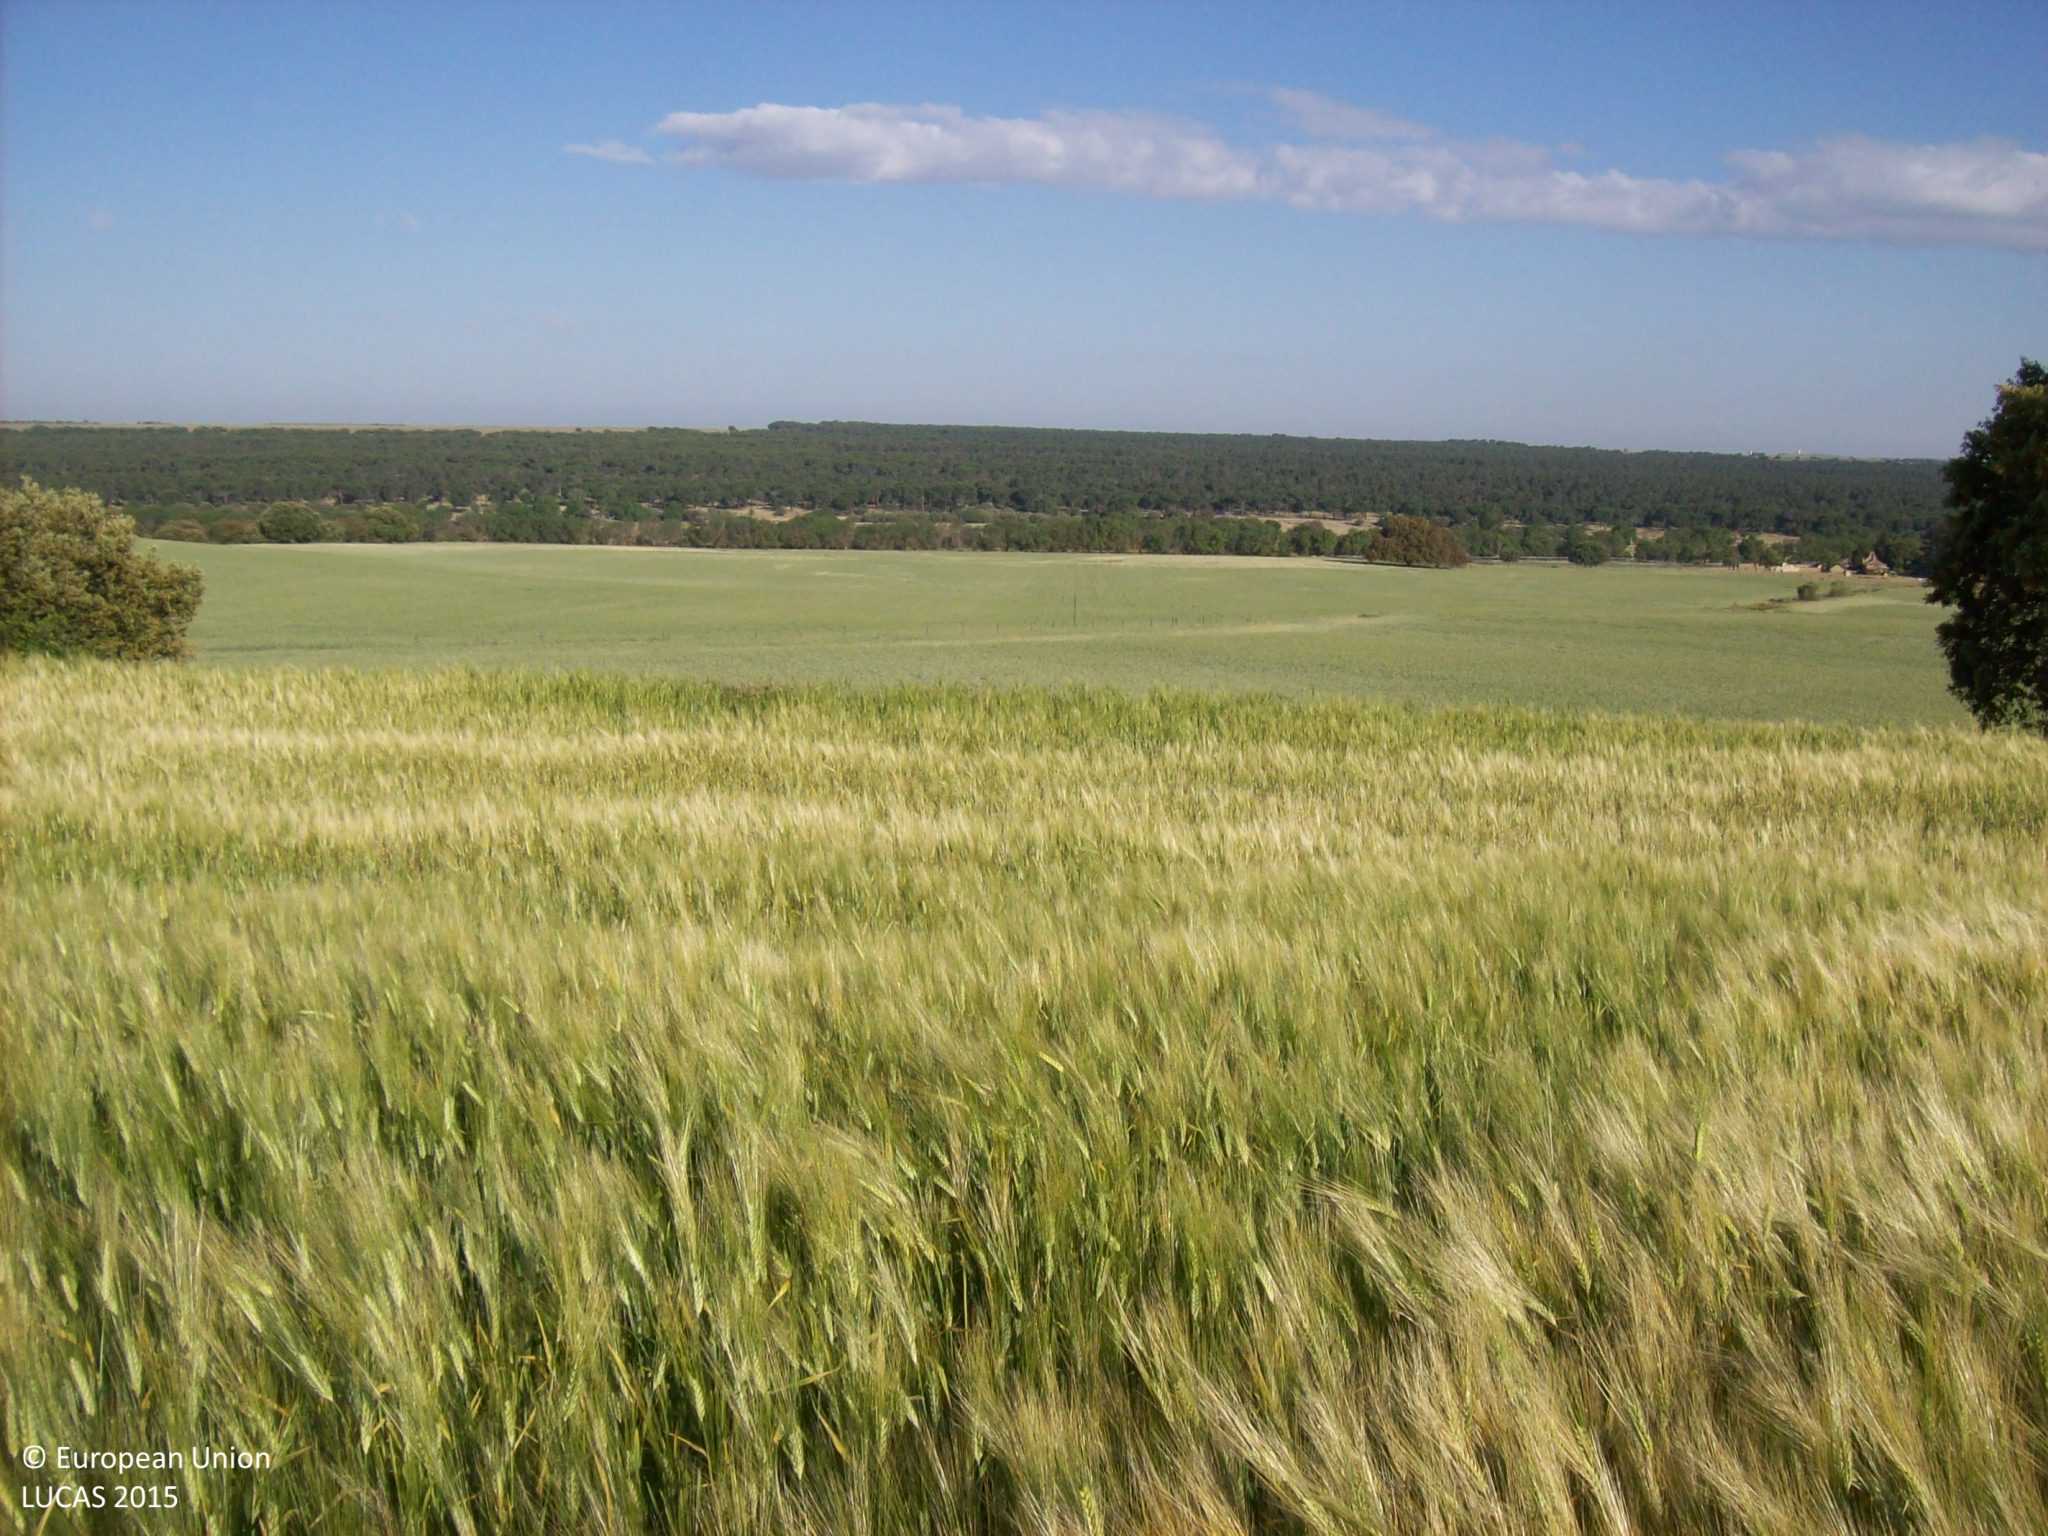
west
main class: Cropland
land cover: Barley
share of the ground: > 75 %
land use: Agriculture (excluding fallow land and kitchen gardens)
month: May
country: ES
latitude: 40.9216
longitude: -4.5313
